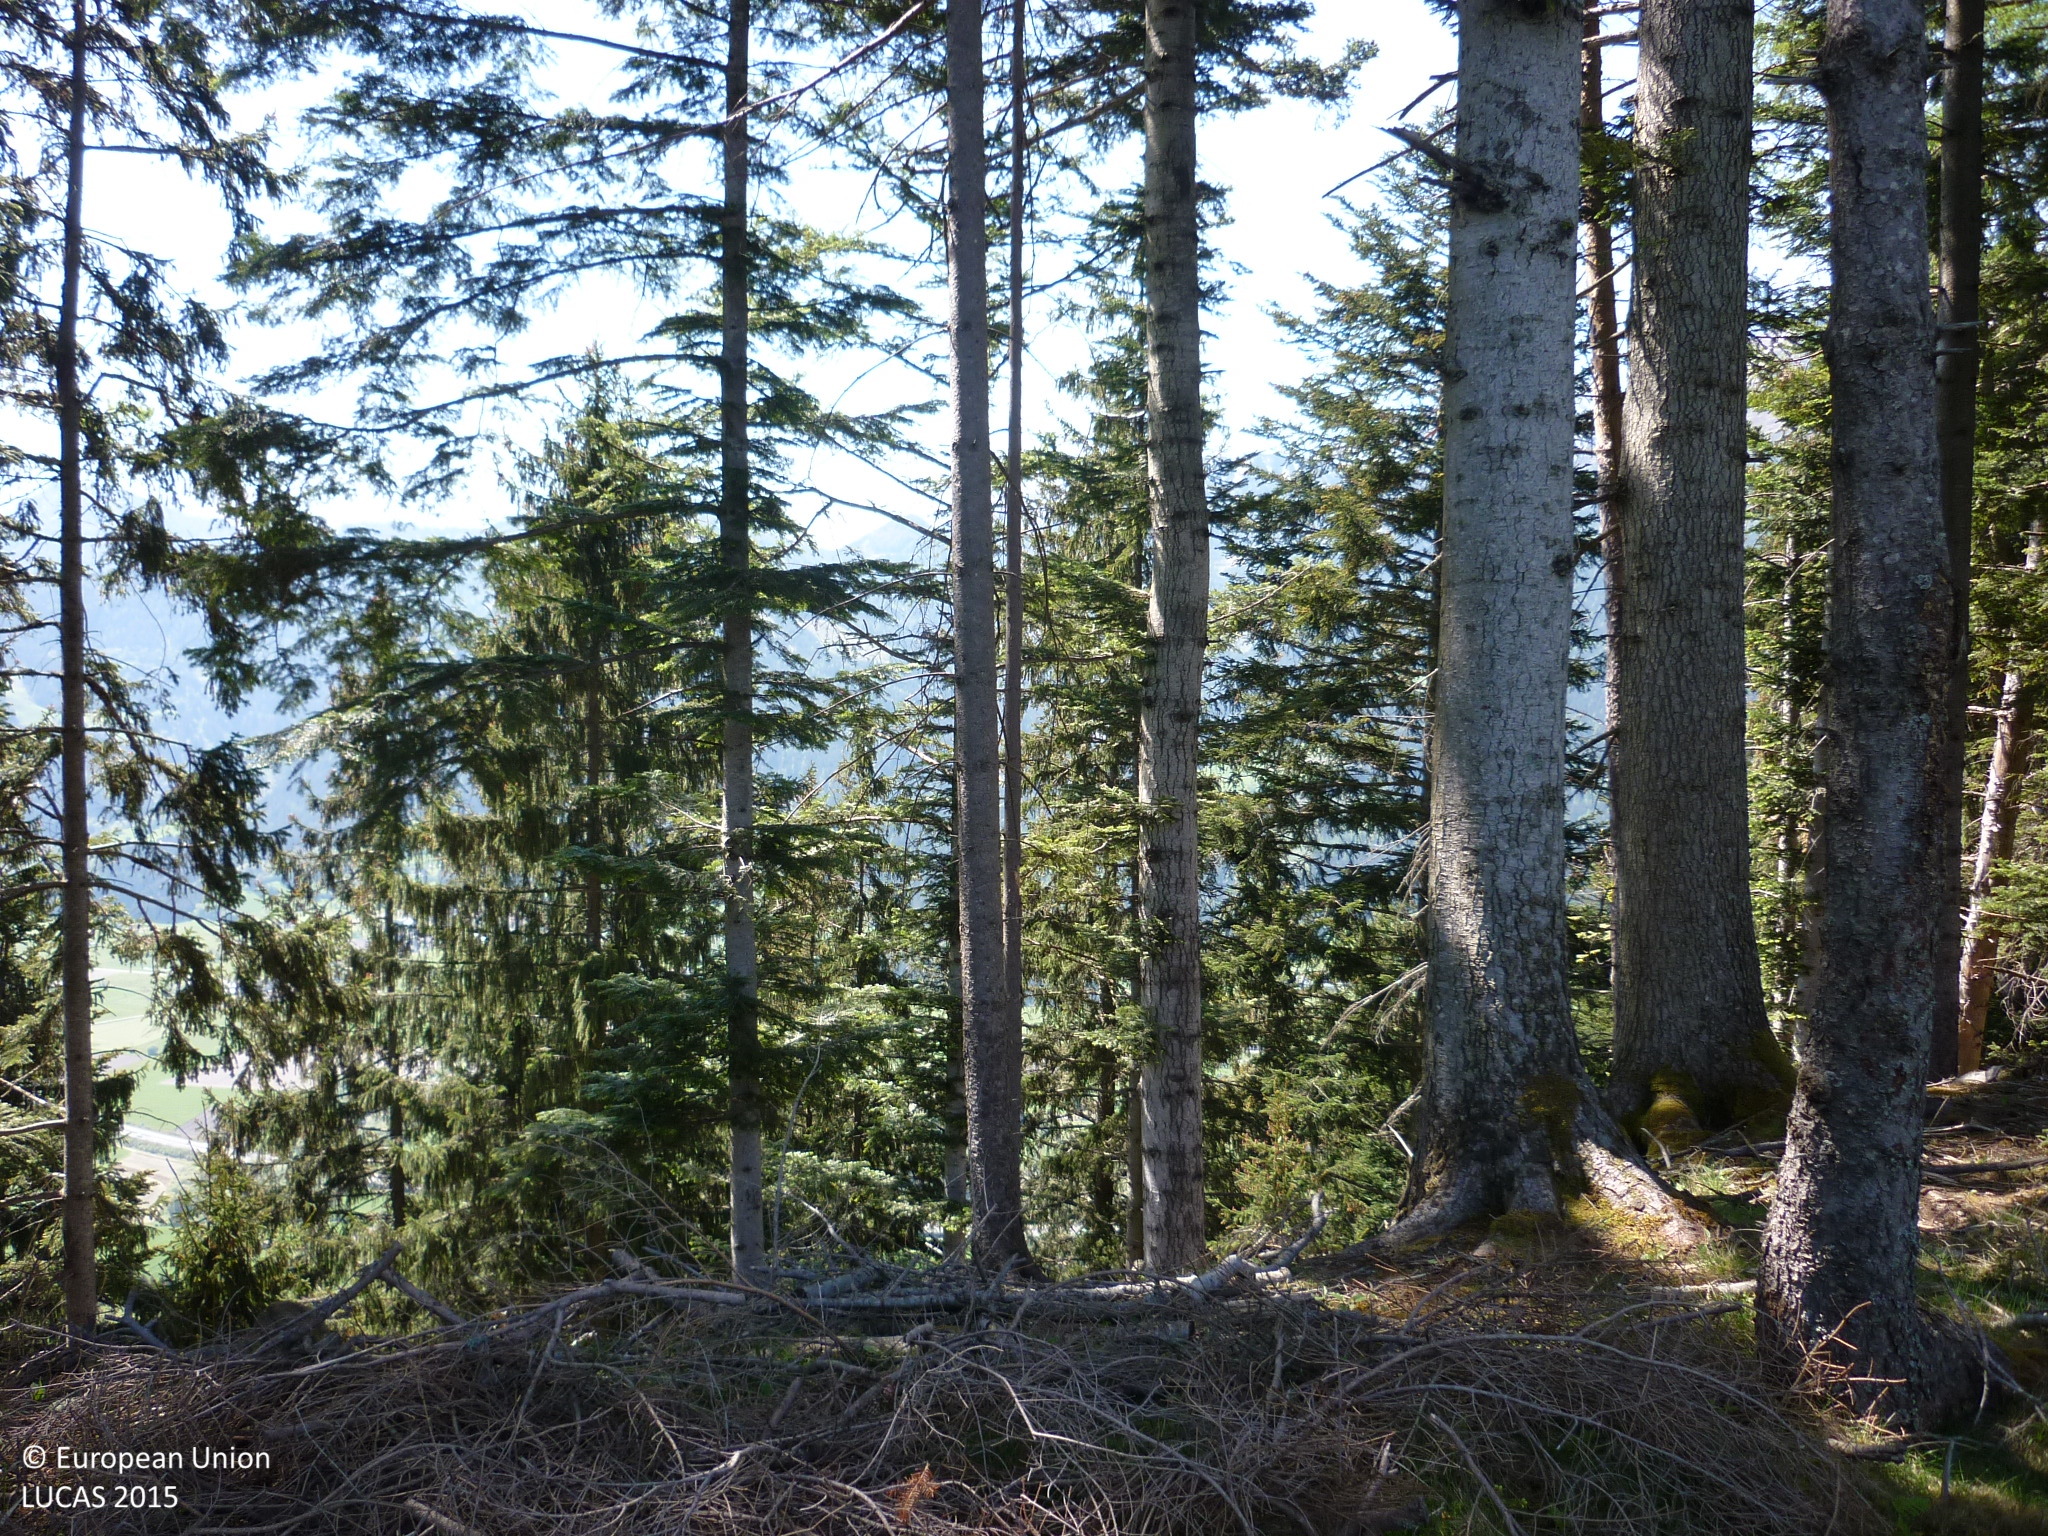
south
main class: Grassland
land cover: Grassland with sparse tree/shrub cover
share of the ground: > 75 %
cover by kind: herbaceous plants 90 %, coniferous forest trees 5 %, lichens and mosses 5 %
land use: Forestry
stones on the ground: < 10 %
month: May
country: AT
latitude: 47.5210
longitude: 14.4481
